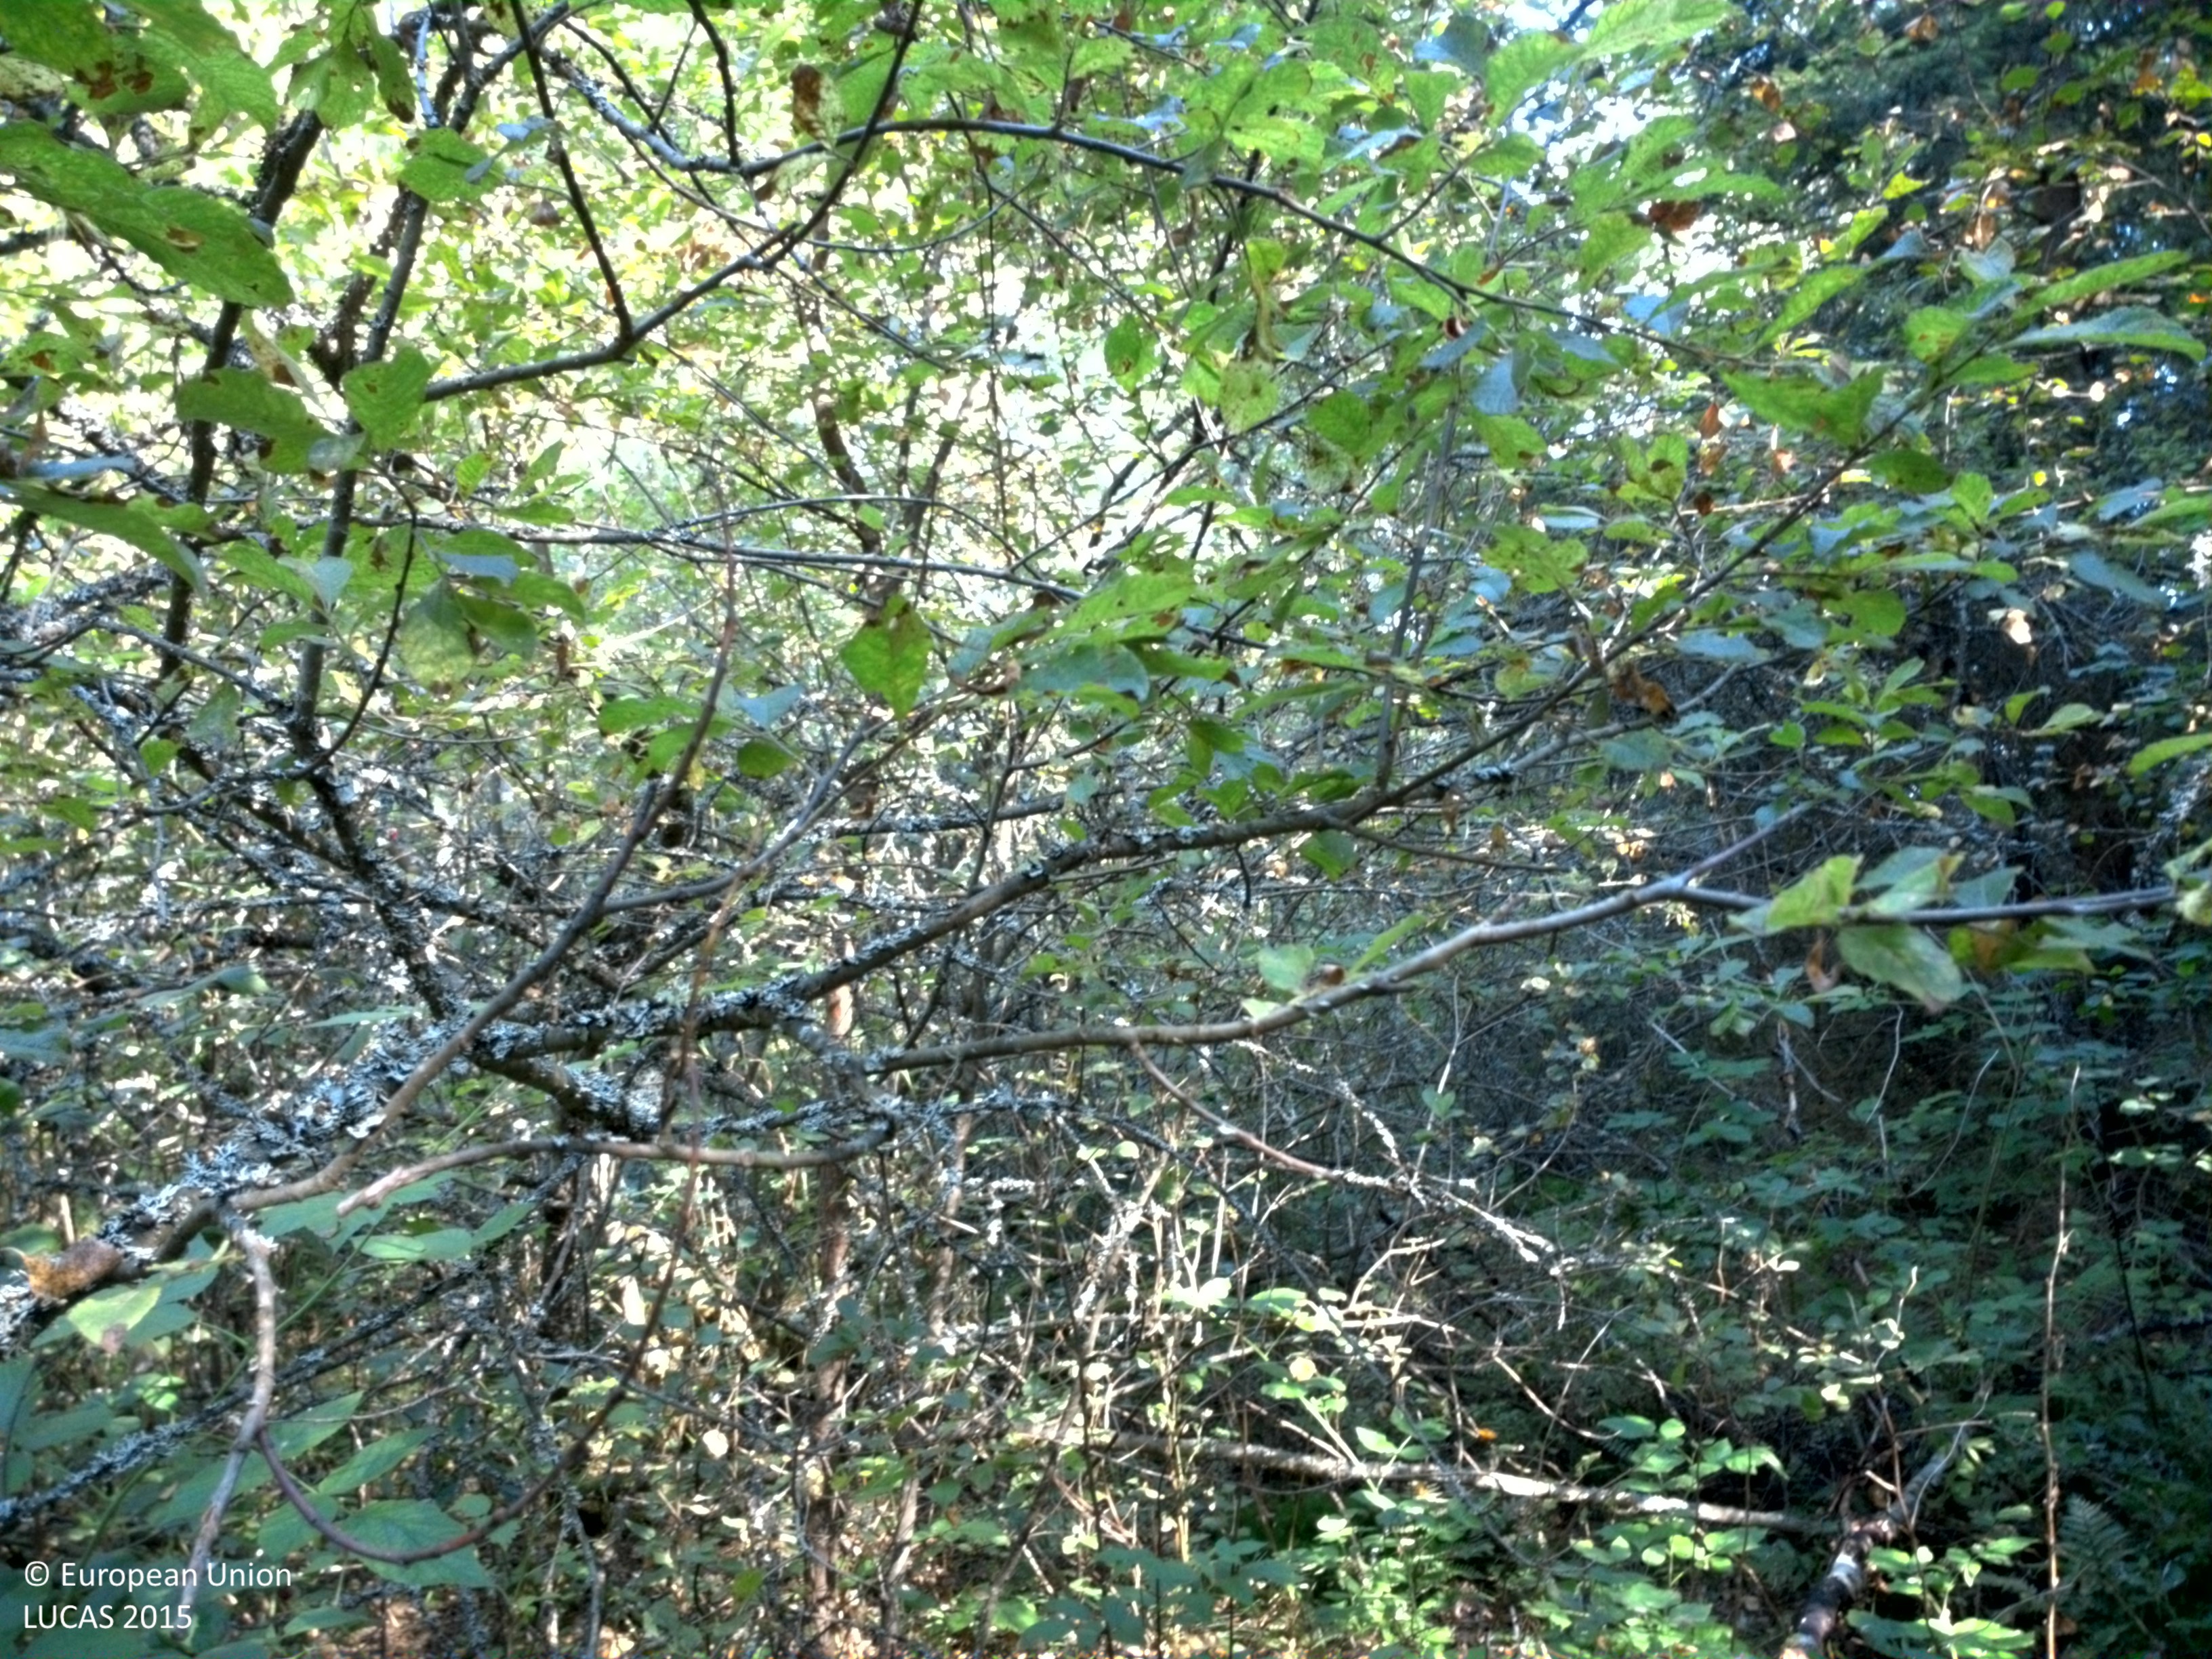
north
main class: Woodland
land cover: Broadleaved woodland
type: boreal forest
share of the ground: 25 - 50 %
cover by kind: broadleaved forest trees 45 %, shrubs 30 %, herbaceous plants 20 %, lichens and mosses 5 %
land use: Forestry
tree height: > 5 m
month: August
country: SE
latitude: 59.4543
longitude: 13.4320
